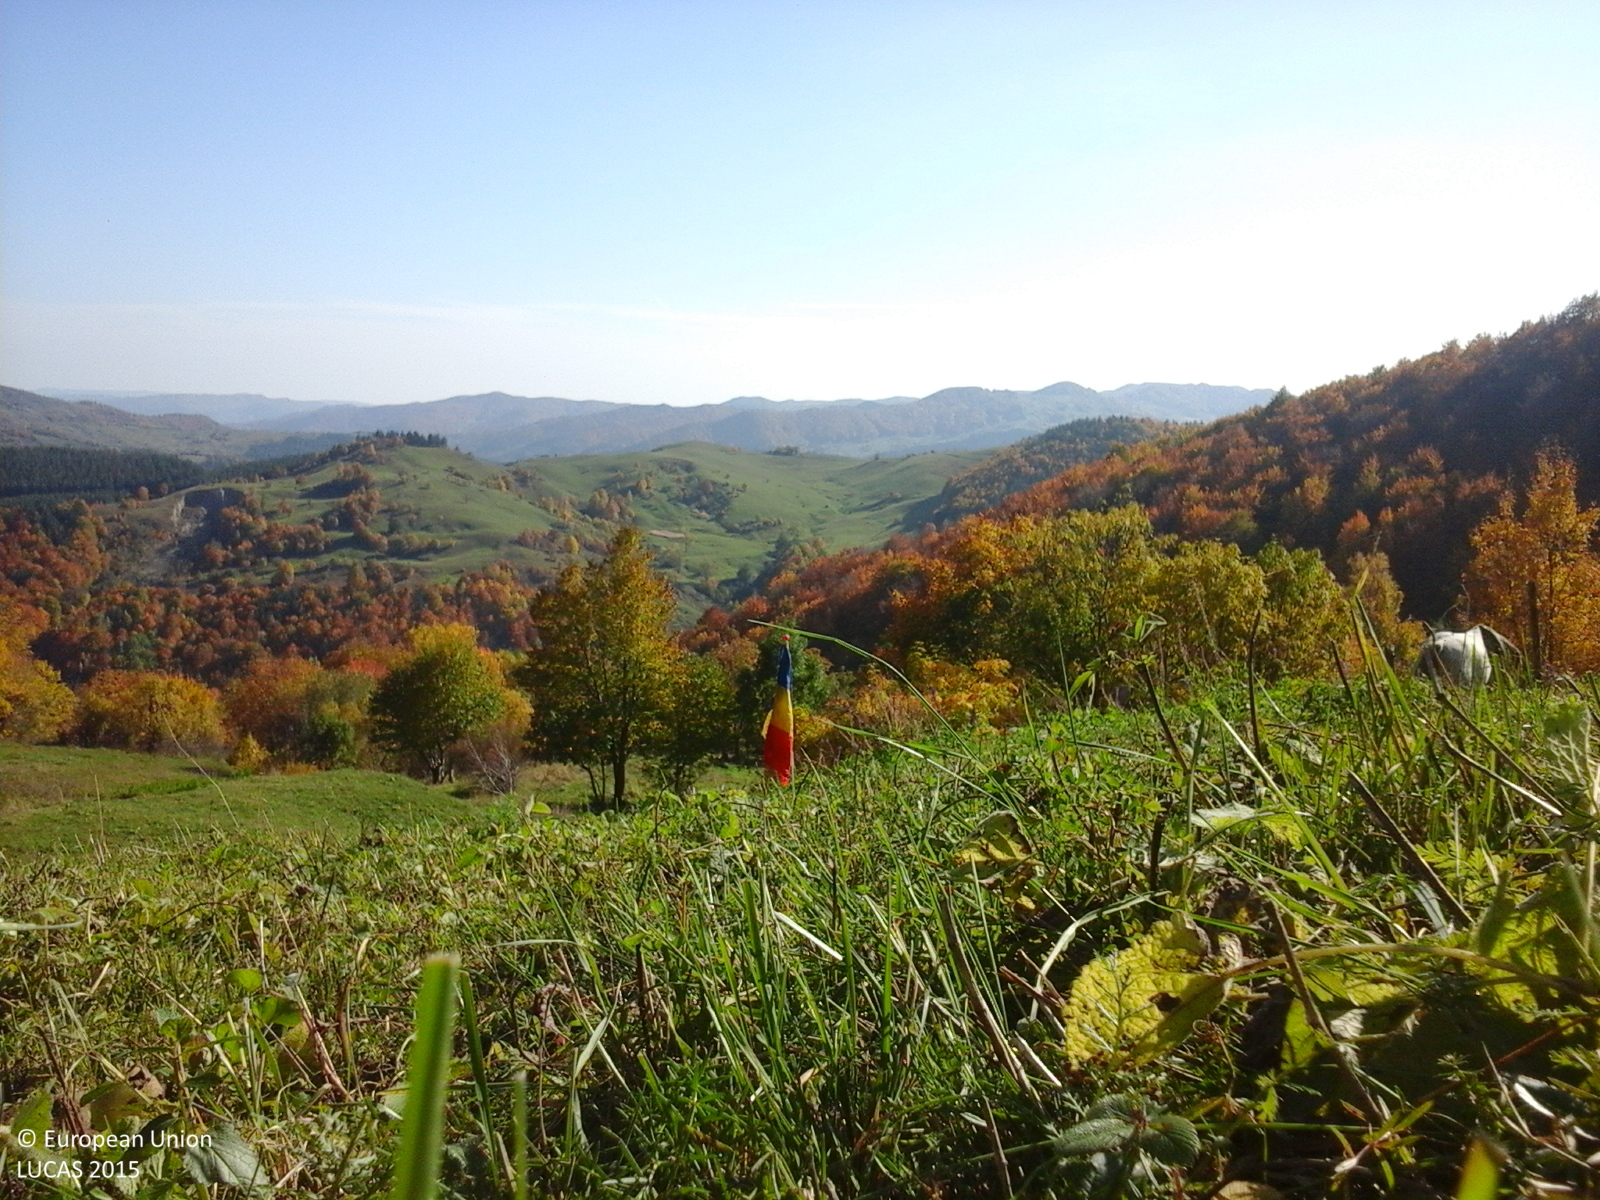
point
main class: Grassland
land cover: Grassland without tree/shrub cover
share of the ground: > 75 %
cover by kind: herbaceous plants 100 %
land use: Agriculture (excluding fallow land and kitchen gardens)
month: October
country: RO
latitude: 45.5195
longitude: 26.6047
